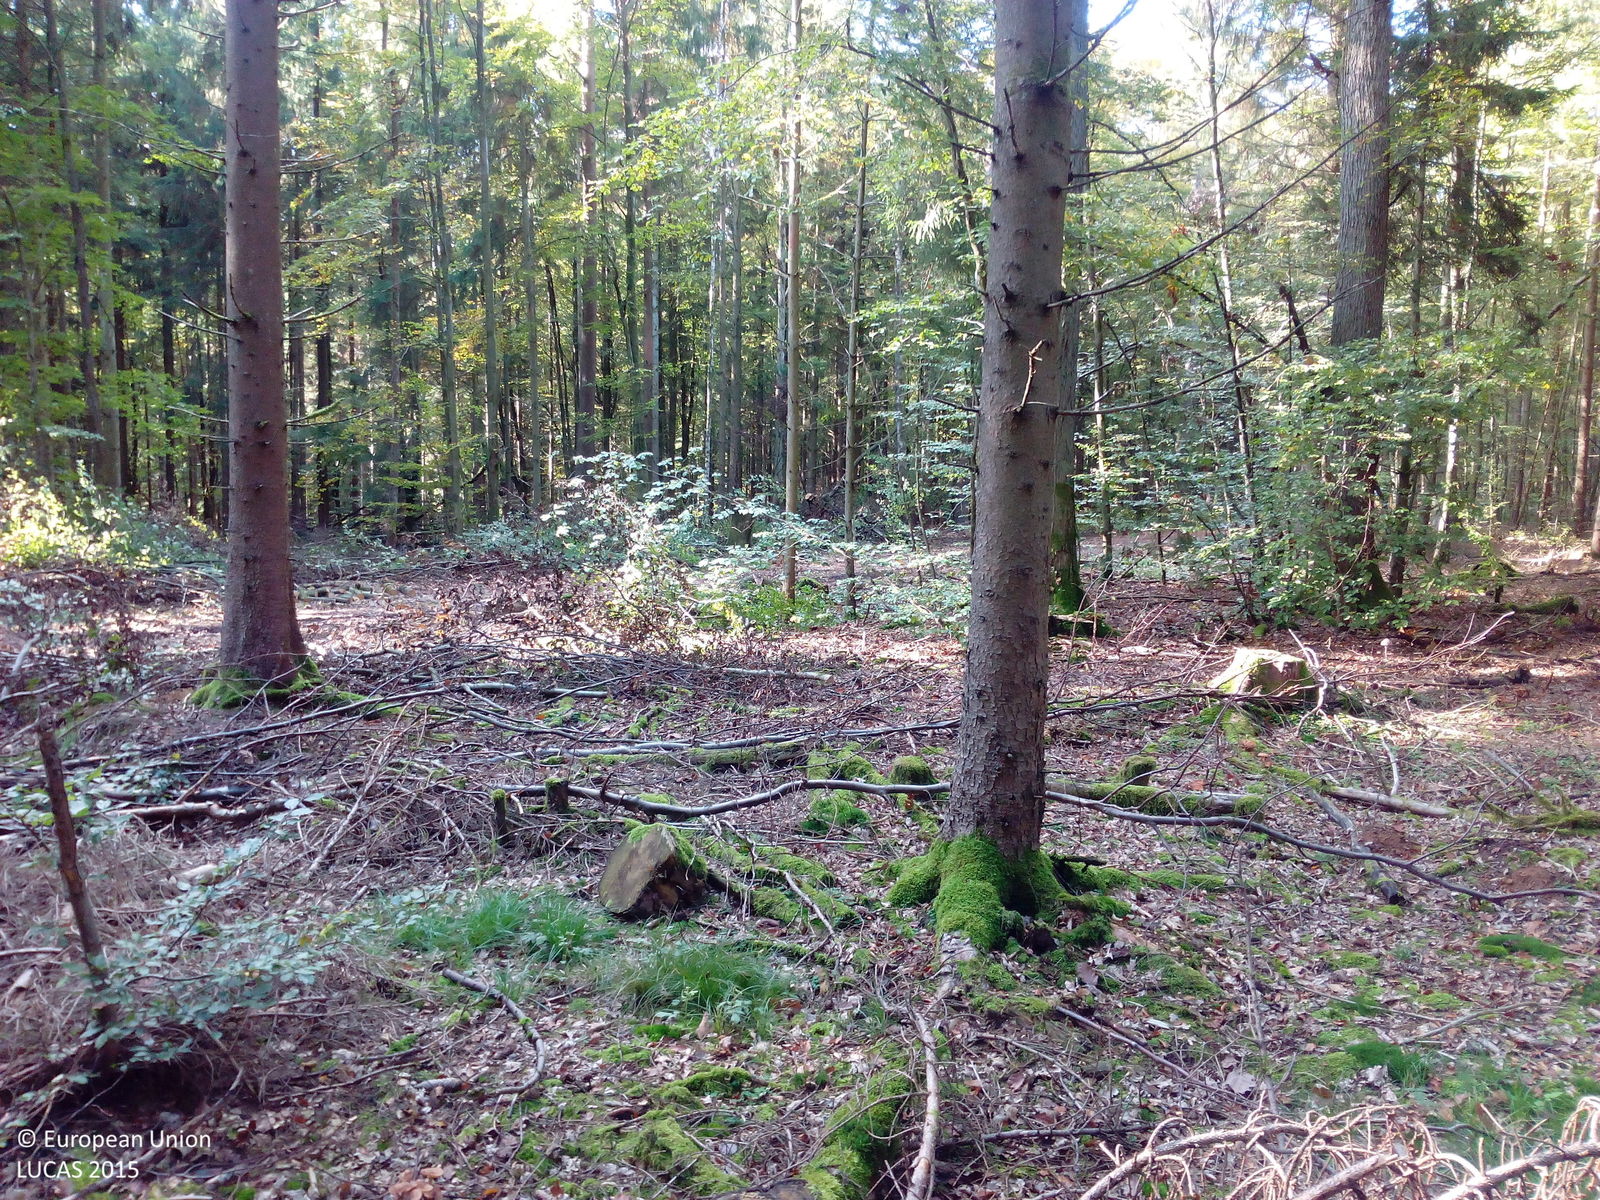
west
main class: Woodland
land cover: Spruce dominated mixed woodland
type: hemiboreal forest and nemoral coniferous forest and mixed broadleaved-coniferous forest
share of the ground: > 75 %
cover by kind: coniferous forest trees 55 %, broadleaved forest trees 20 %, herbaceous plants 15 %, shrubs 5 %, lichens and mosses 5 %
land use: Forestry
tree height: > 5 m
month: October
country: DE
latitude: 50.0927
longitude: 9.3991
